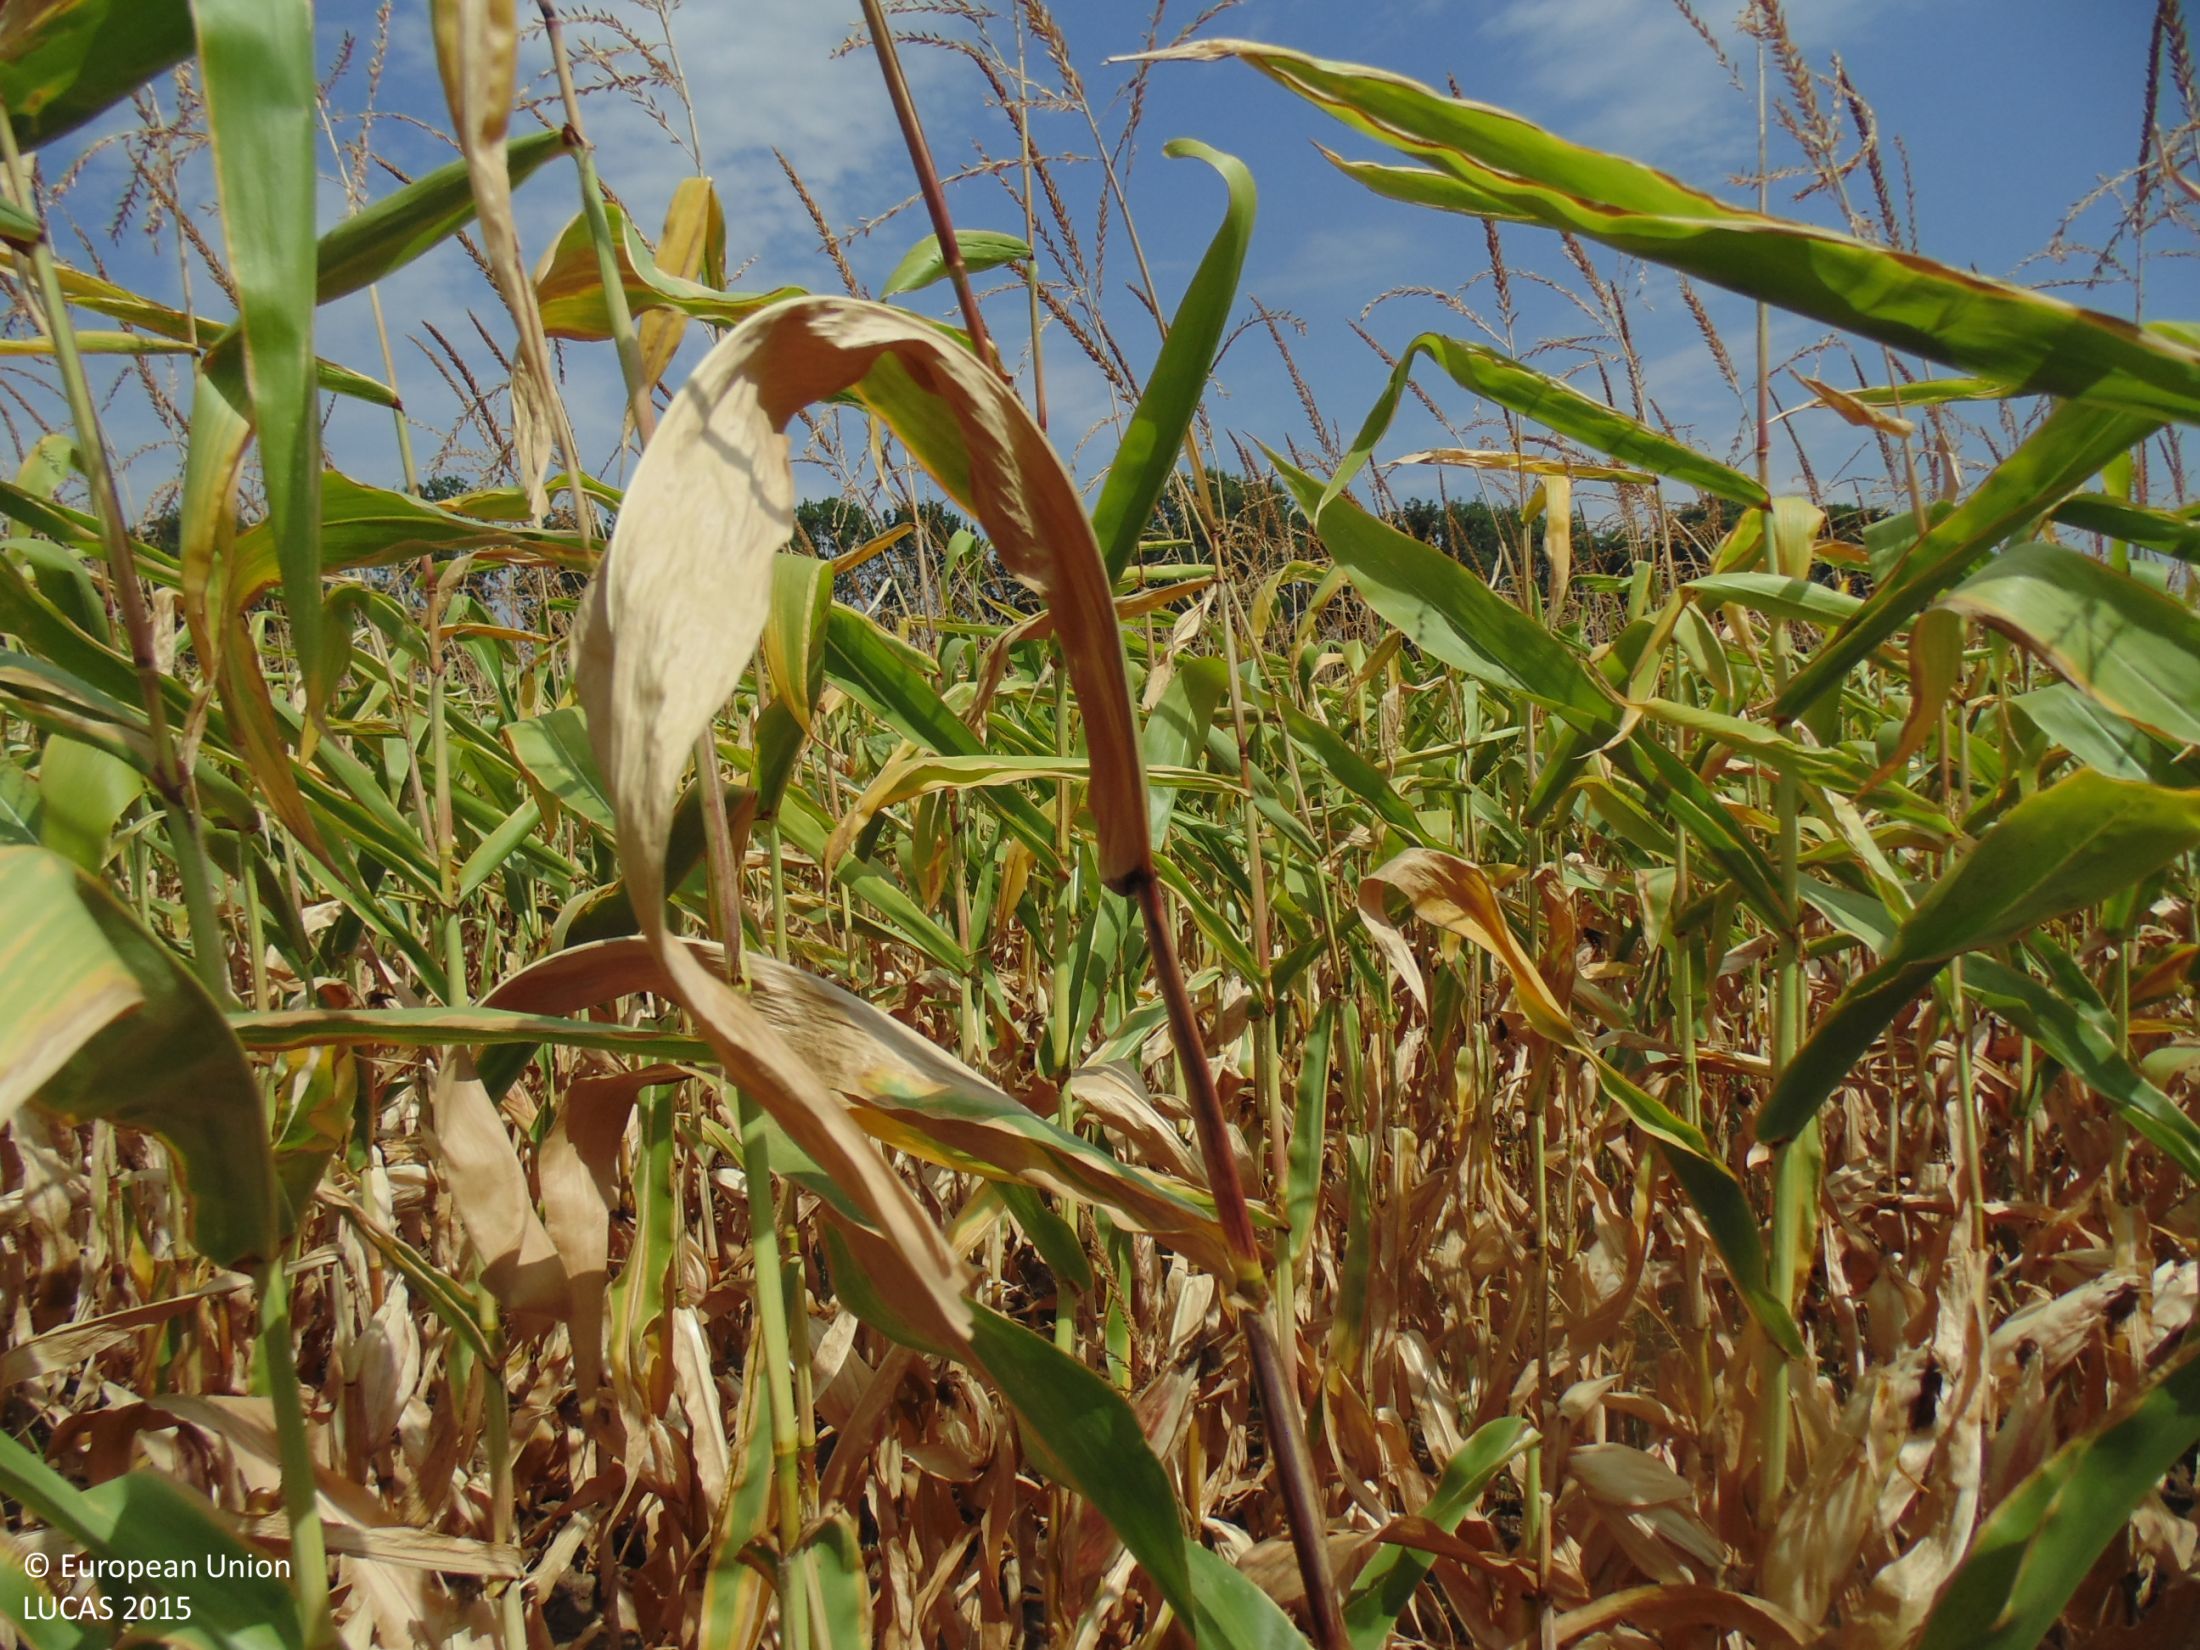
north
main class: Cropland
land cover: Maize
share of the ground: > 75 %
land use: Agriculture (excluding fallow land and kitchen gardens)
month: August
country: BG
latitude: 43.9571
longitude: 27.8040
